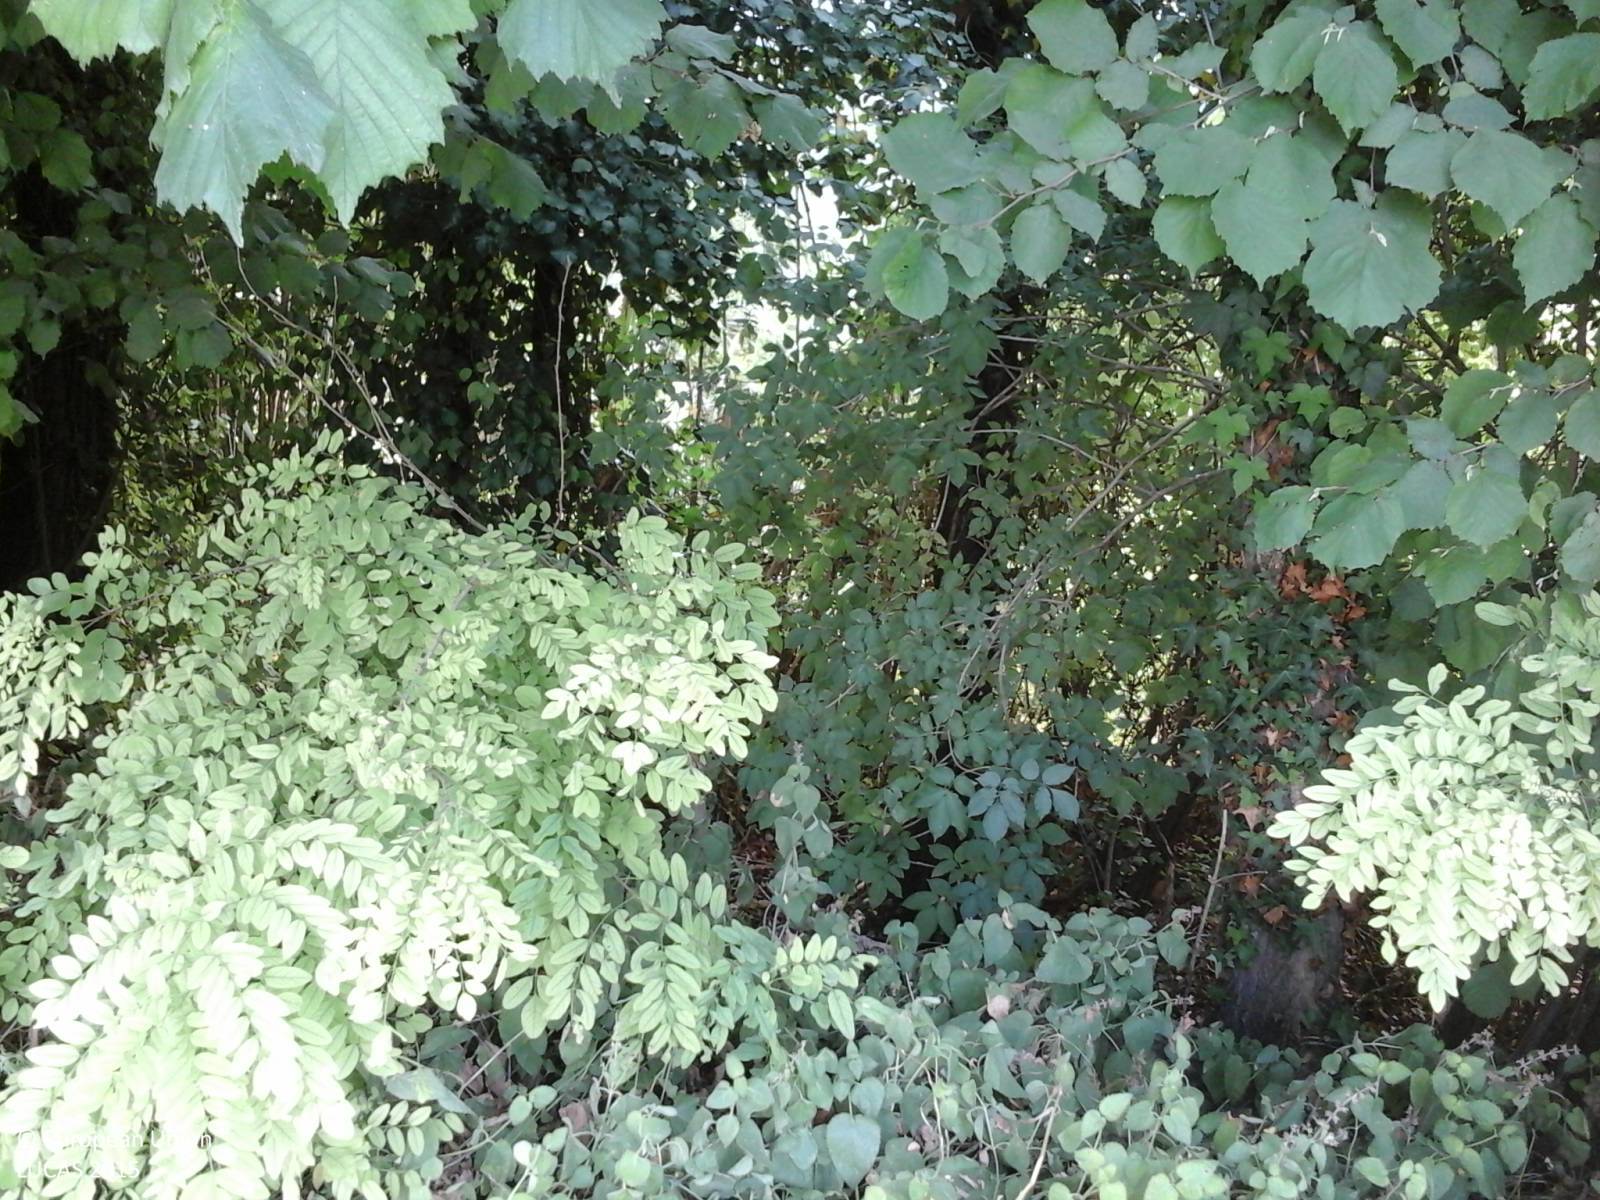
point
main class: Woodland
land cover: Broadleaved woodland
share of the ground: > 75 %
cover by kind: broadleaved forest trees 100 %
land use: Semi-natural and natural areas not in use
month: August
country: IT
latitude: 41.4421
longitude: 13.8274
